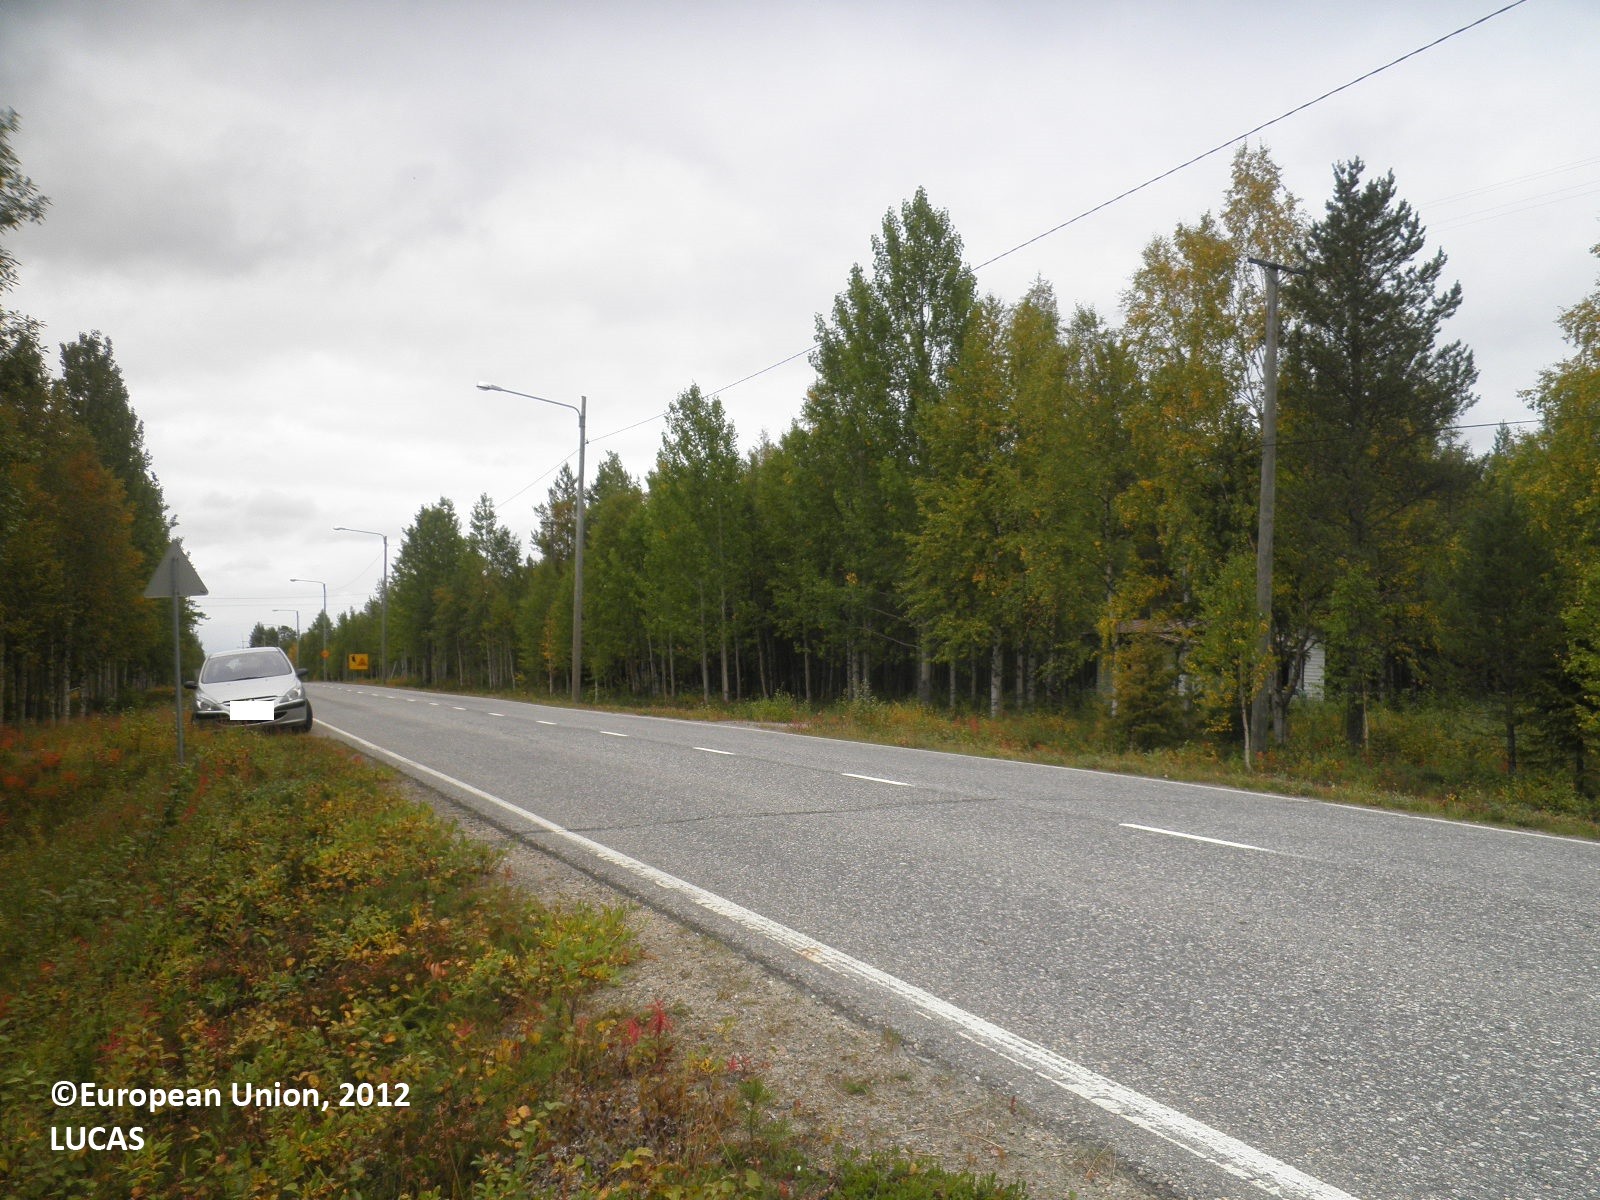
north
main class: Shrubland
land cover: Shrubland with sparse tree cover
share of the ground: > 75 %
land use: Road transport
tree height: < 5 m
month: August
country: FI
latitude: 67.2982
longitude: 28.1626
